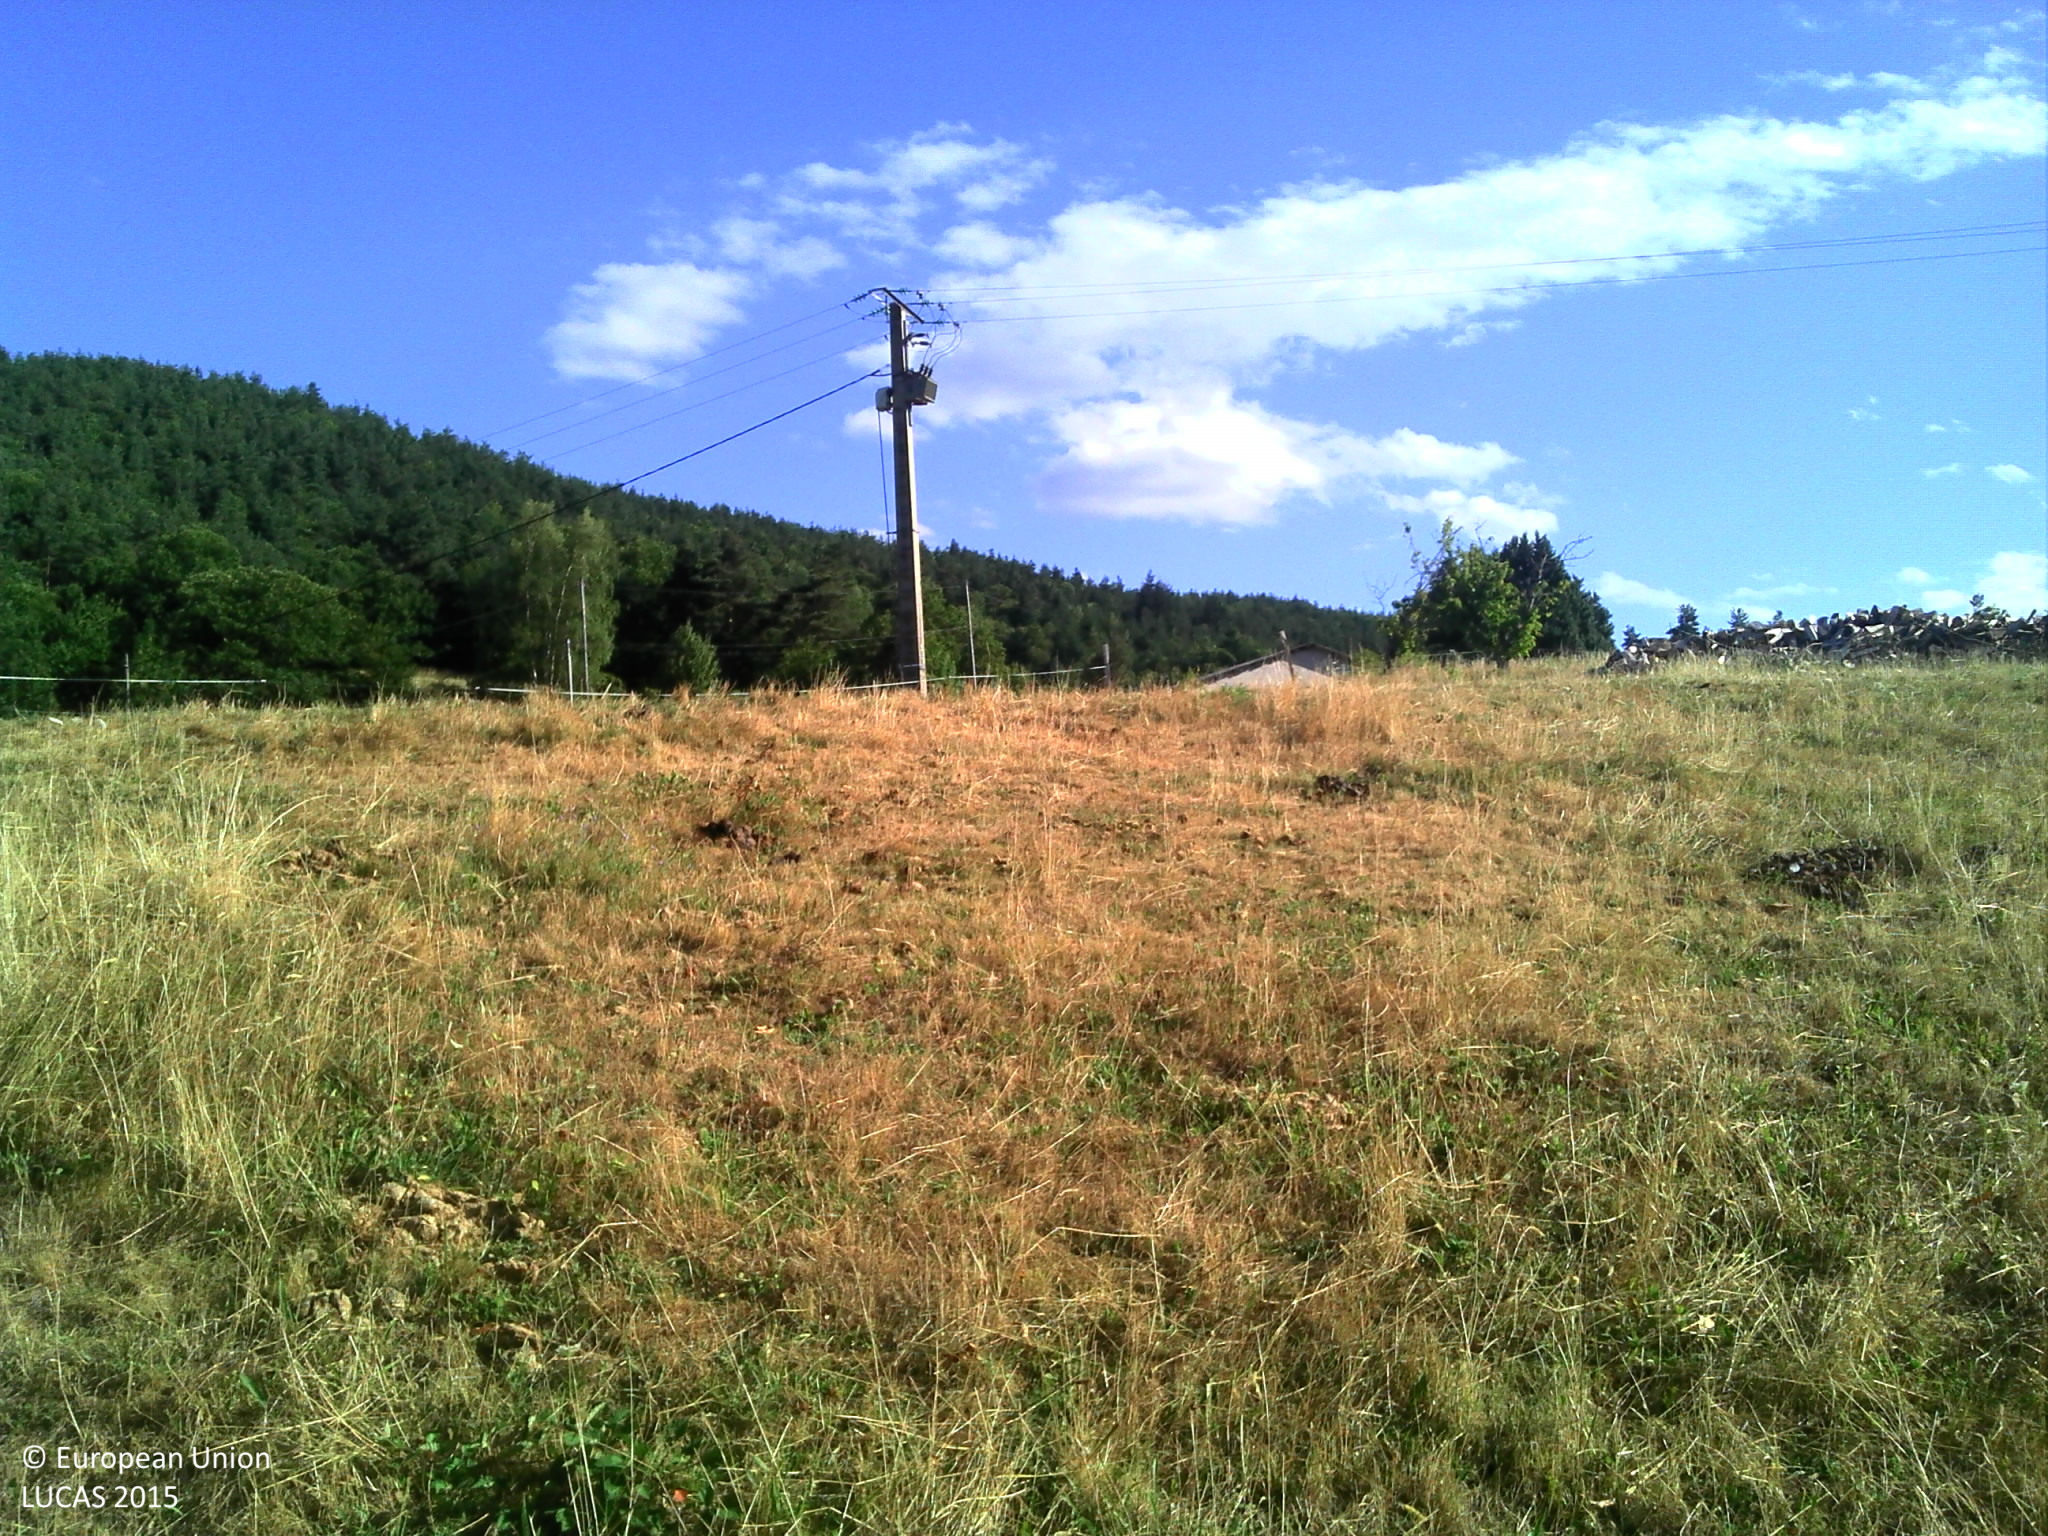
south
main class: Grassland
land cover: Grassland without tree/shrub cover
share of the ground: > 75 %
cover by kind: herbaceous plants 100 %
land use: Agriculture (excluding fallow land and kitchen gardens)
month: July
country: FR
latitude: 44.9504
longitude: 4.5932
